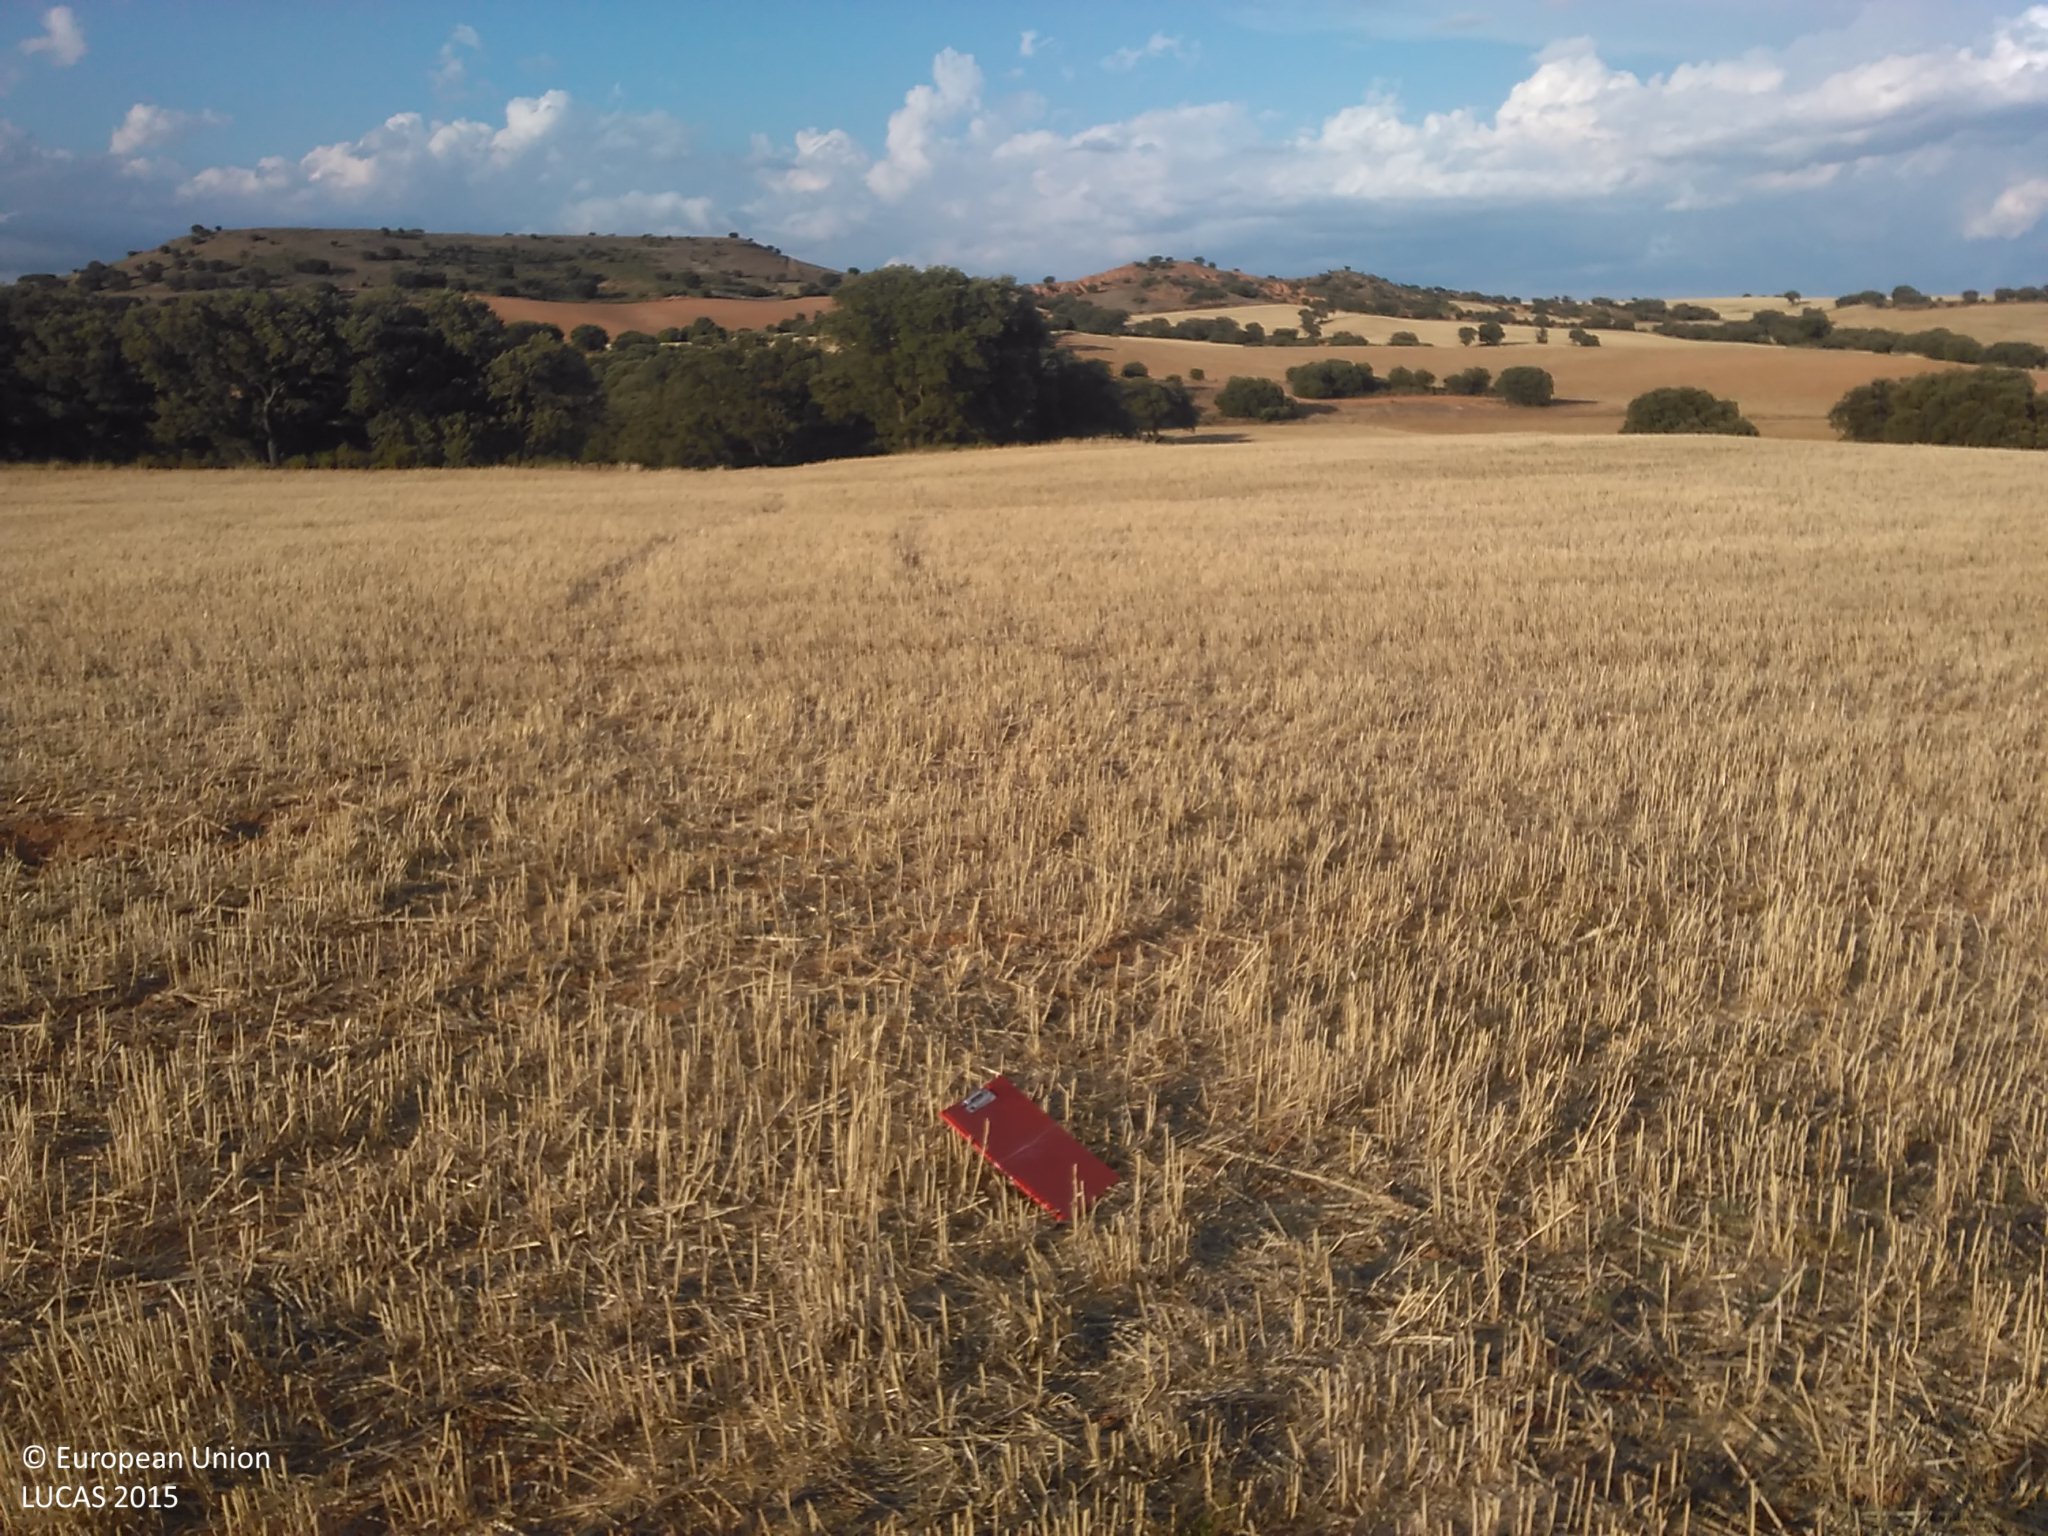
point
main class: Cropland
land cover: Barley
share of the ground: < 10 %
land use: Agriculture (excluding fallow land and kitchen gardens)
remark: Harvested field
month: July
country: ES
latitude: 41.4179
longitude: -2.2233
